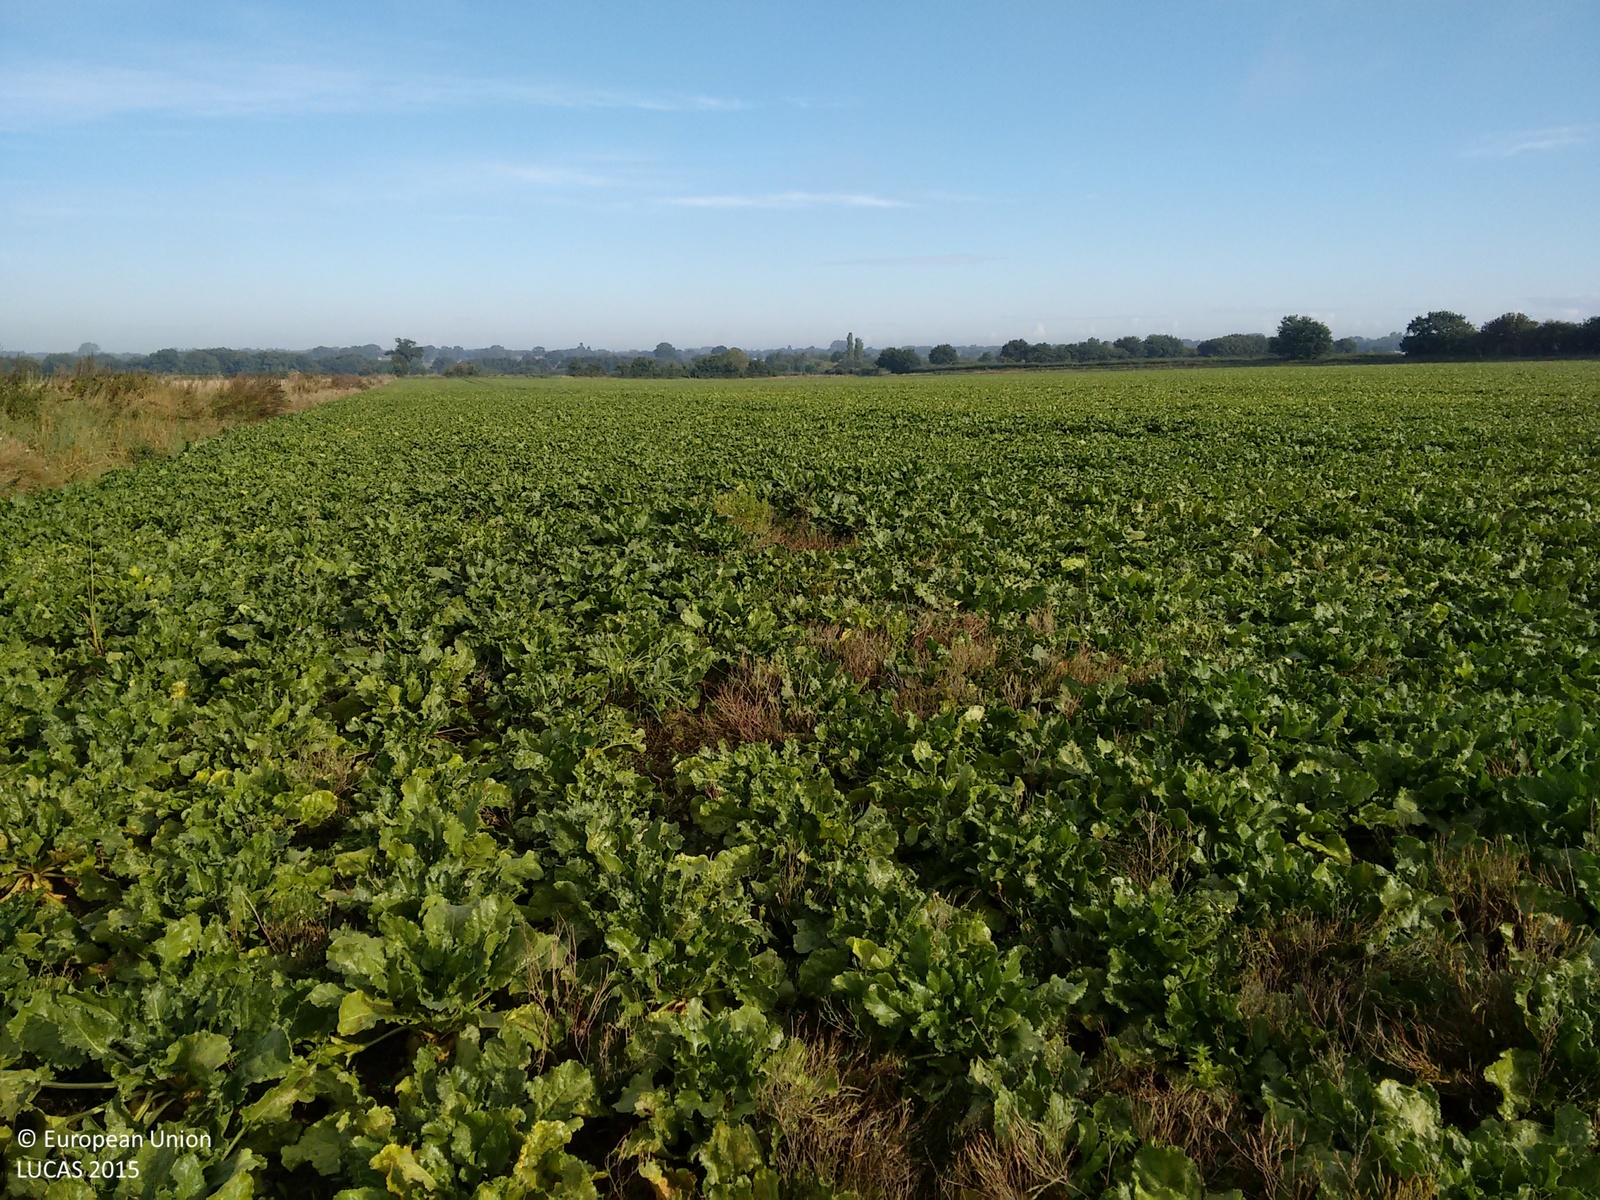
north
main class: Cropland
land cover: Sugar beet
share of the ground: > 75 %
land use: Agriculture (excluding fallow land and kitchen gardens)
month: September
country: GB
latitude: 52.6902
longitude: 1.2949
